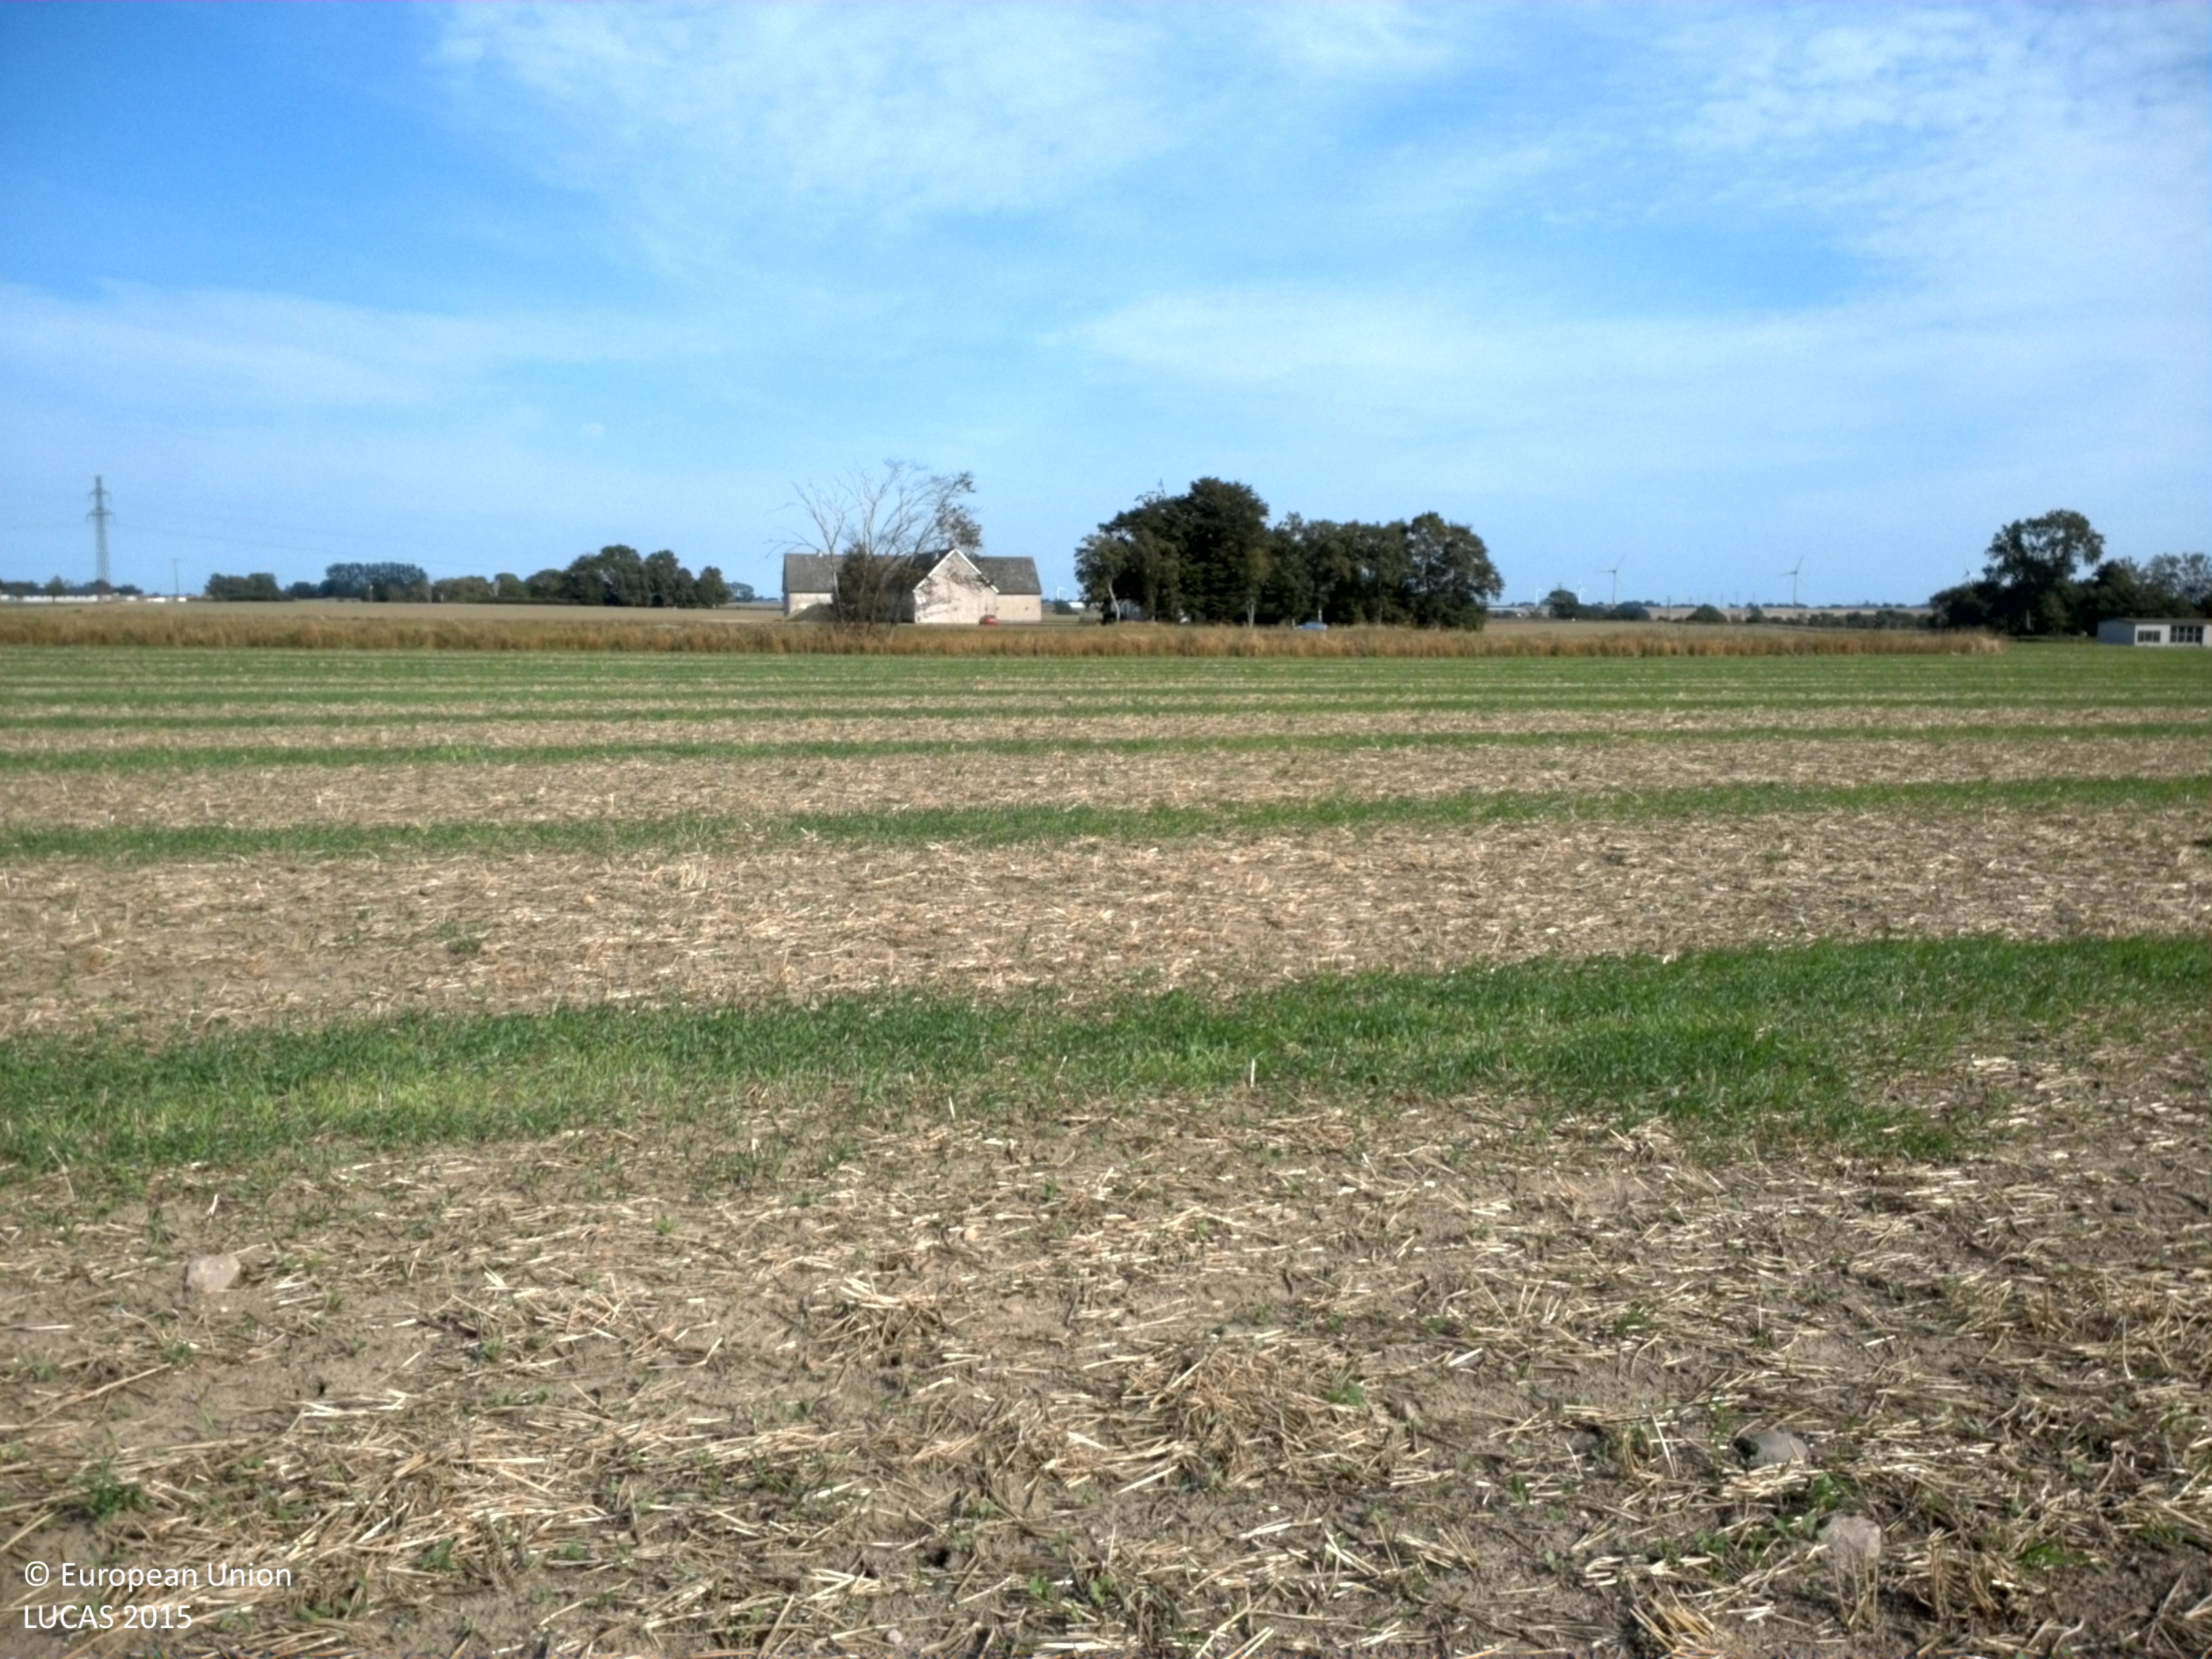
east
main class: Cropland
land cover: Other leguminous and mixtures for fodder
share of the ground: 10 - 25 %
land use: Agriculture (excluding fallow land and kitchen gardens)
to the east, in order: Other leguminous and mixtures for fodder; Ditches and canals; Temporary grasslands; Strawberries; Temporary grasslands; Artificial constructions in urban areas
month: September
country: SE
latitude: 55.5303
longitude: 14.0384
